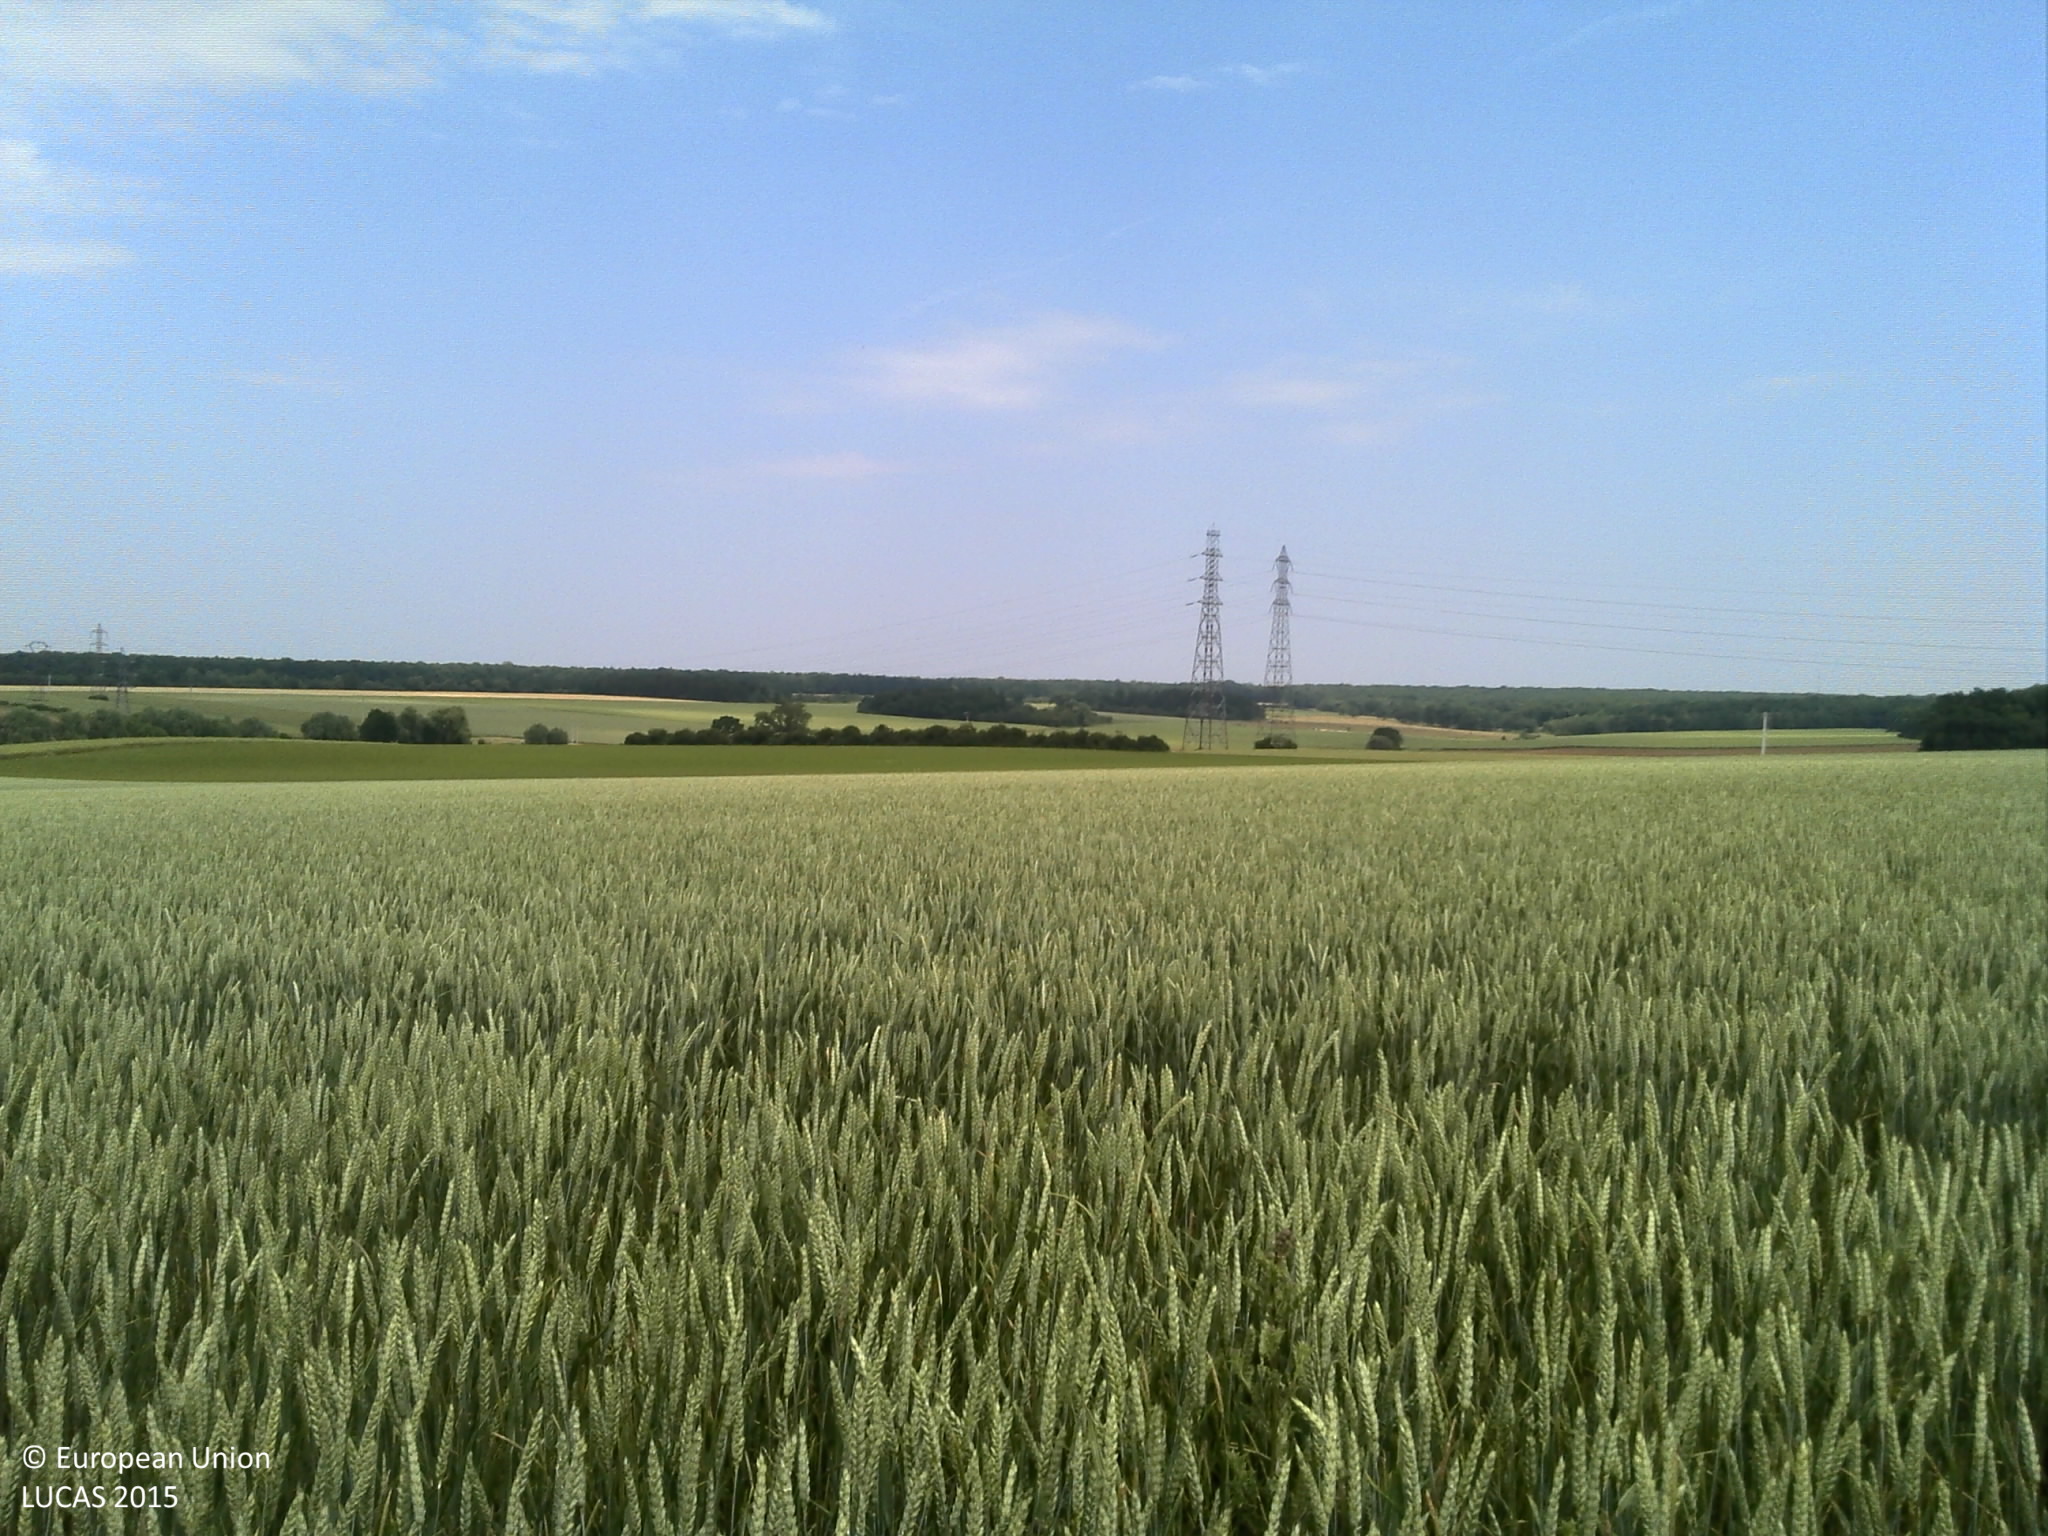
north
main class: Cropland
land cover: Common wheat
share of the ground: > 75 %
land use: Agriculture (excluding fallow land and kitchen gardens)
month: June
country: FR
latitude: 49.2045
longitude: 6.2527
